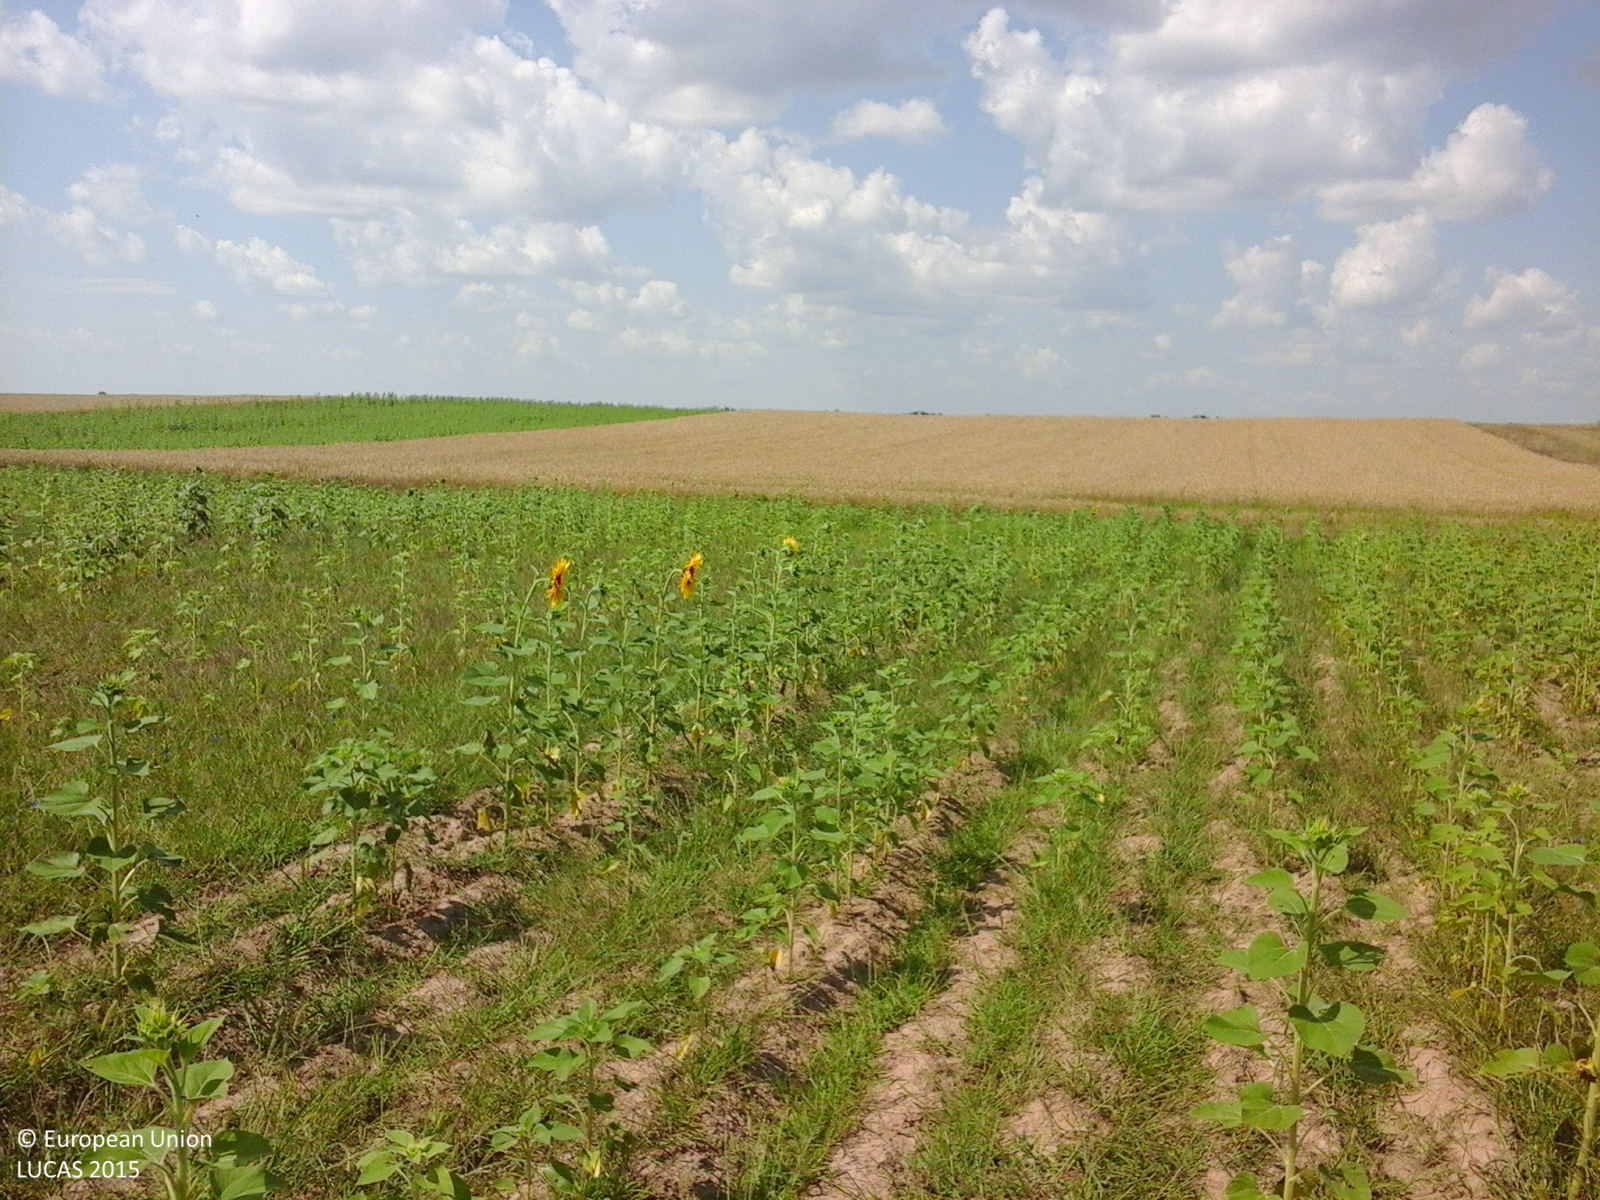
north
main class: Cropland
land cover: Sunflower
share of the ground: > 75 %
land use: Agriculture (excluding fallow land and kitchen gardens)
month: July
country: RO
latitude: 44.0196
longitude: 24.1190
